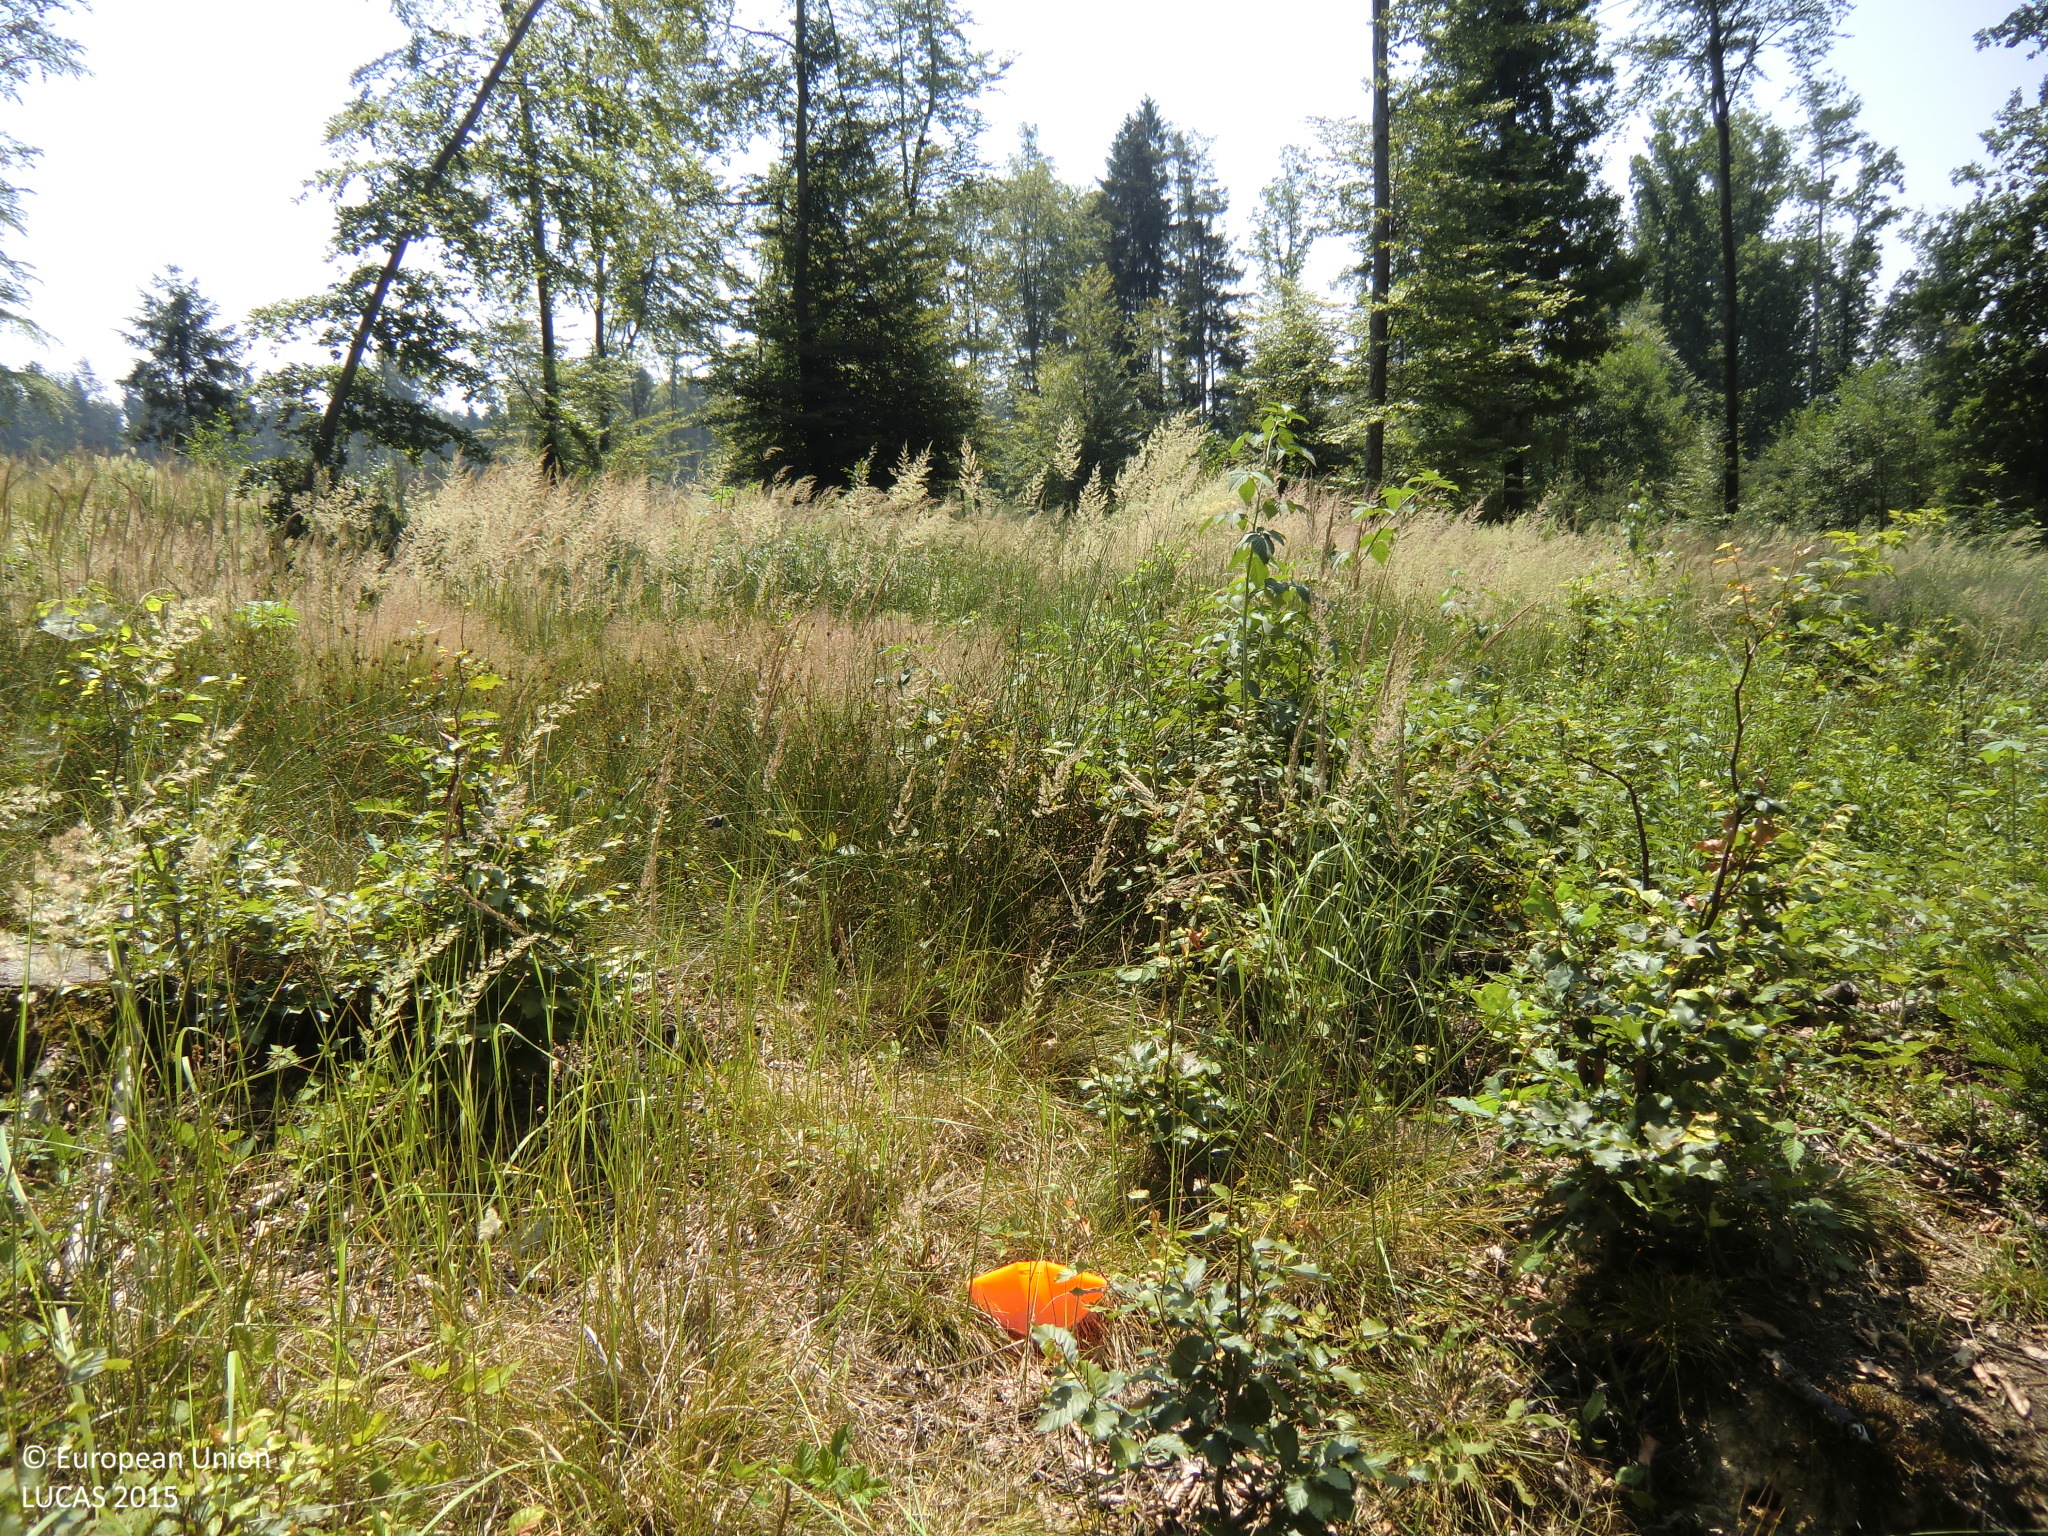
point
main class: Shrubland
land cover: Shrubland with sparse tree cover
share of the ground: > 75 %
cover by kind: herbaceous plants 55 %, shrubs 40 %, broadleaved forest trees 5 %
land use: Forestry
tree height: < 5 m
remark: Clear cut
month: July
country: AT
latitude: 47.1001
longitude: 15.7320
